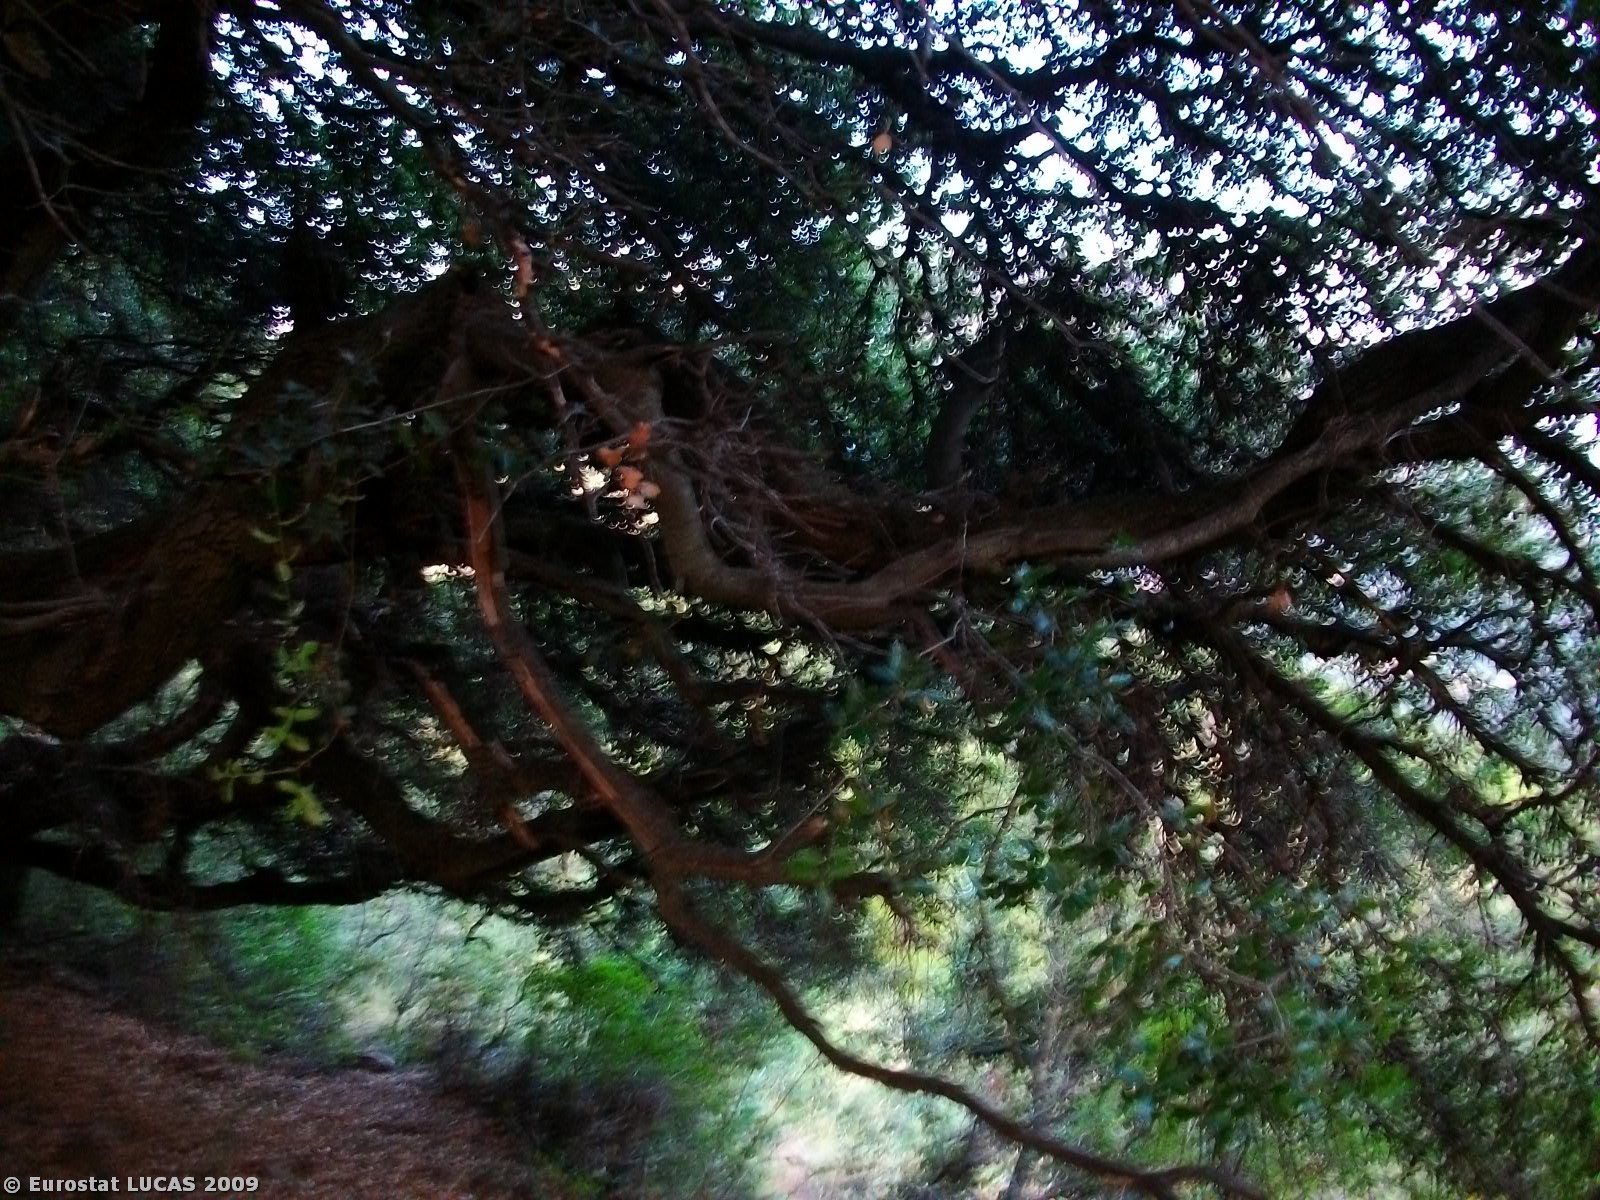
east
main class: Shrubland
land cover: Shrubland with sparse tree cover
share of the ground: > 75 %
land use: Agriculture (excluding fallow land and kitchen gardens)
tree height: < 5 m
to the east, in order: Shrubland with sparse tree cover; Tracks; Shrubland with sparse tree cover; Dry stone walls; Shrubland with sparse tree cover; Grassland without tree/shrub cover
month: July
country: GR
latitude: 38.4303
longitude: 22.1495
